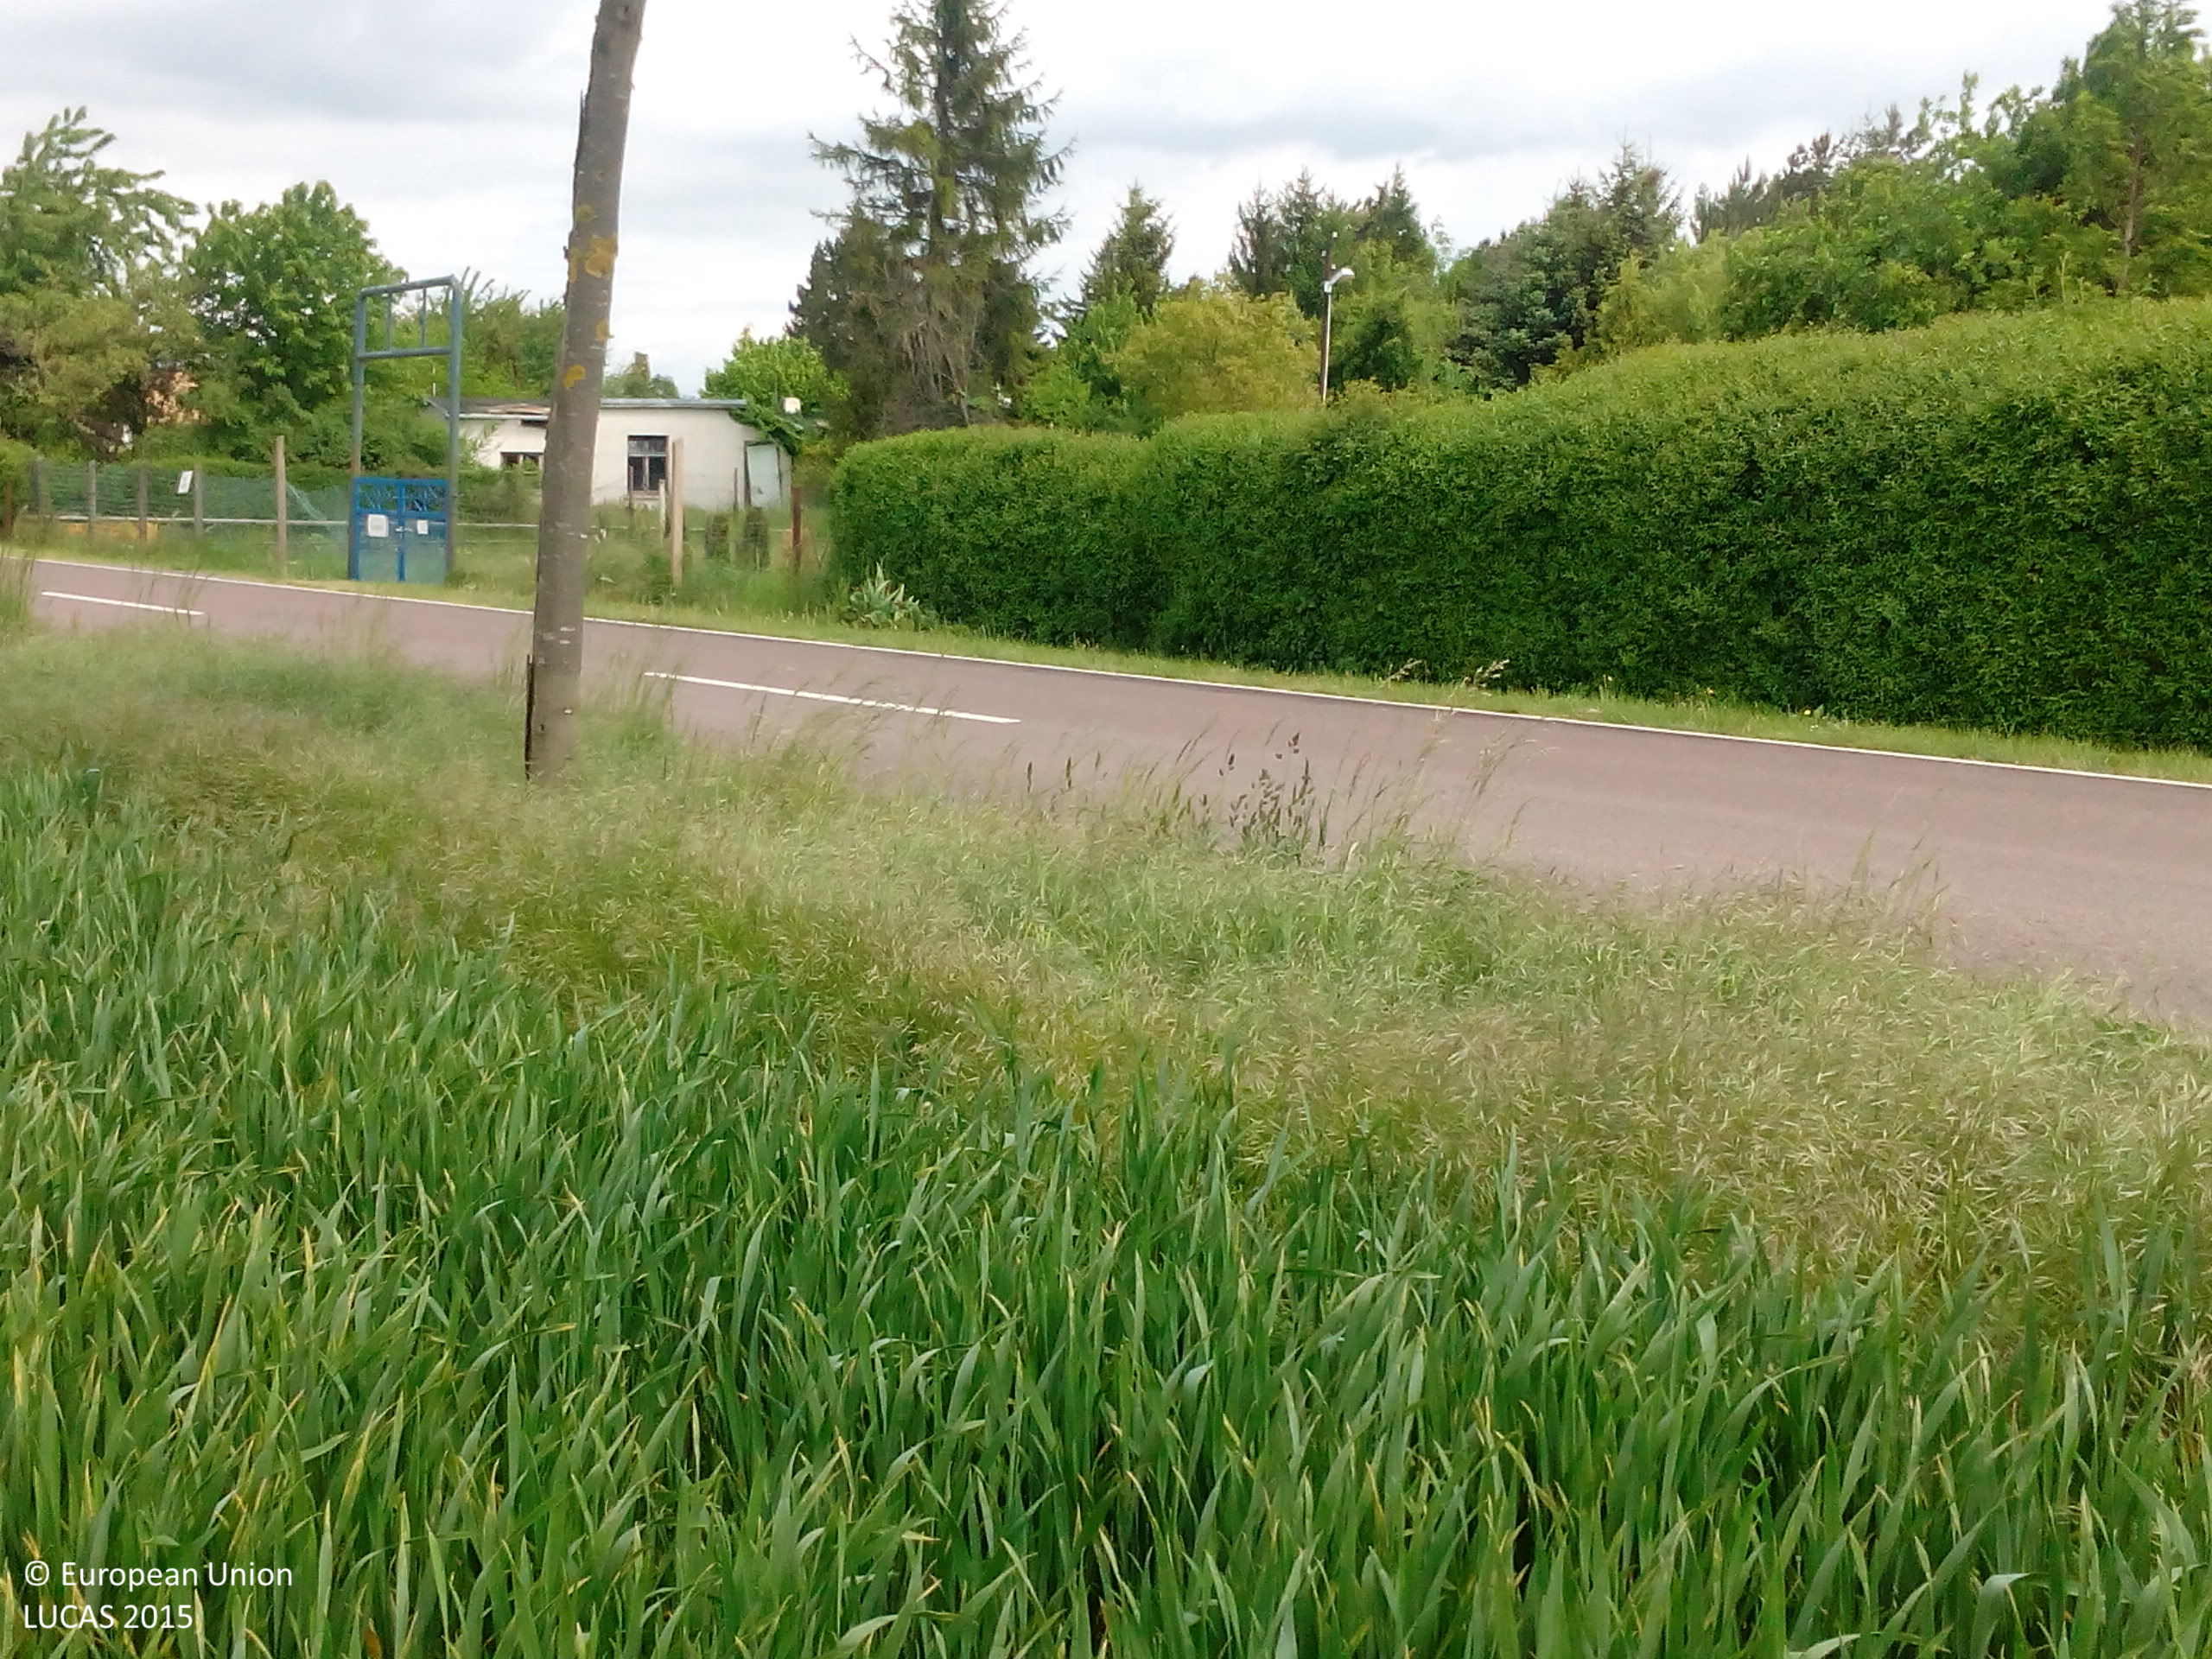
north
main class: Cropland
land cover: Common wheat
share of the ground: > 75 %
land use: Agriculture (excluding fallow land and kitchen gardens)
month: May
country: DE
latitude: 51.5658
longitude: 12.2069
